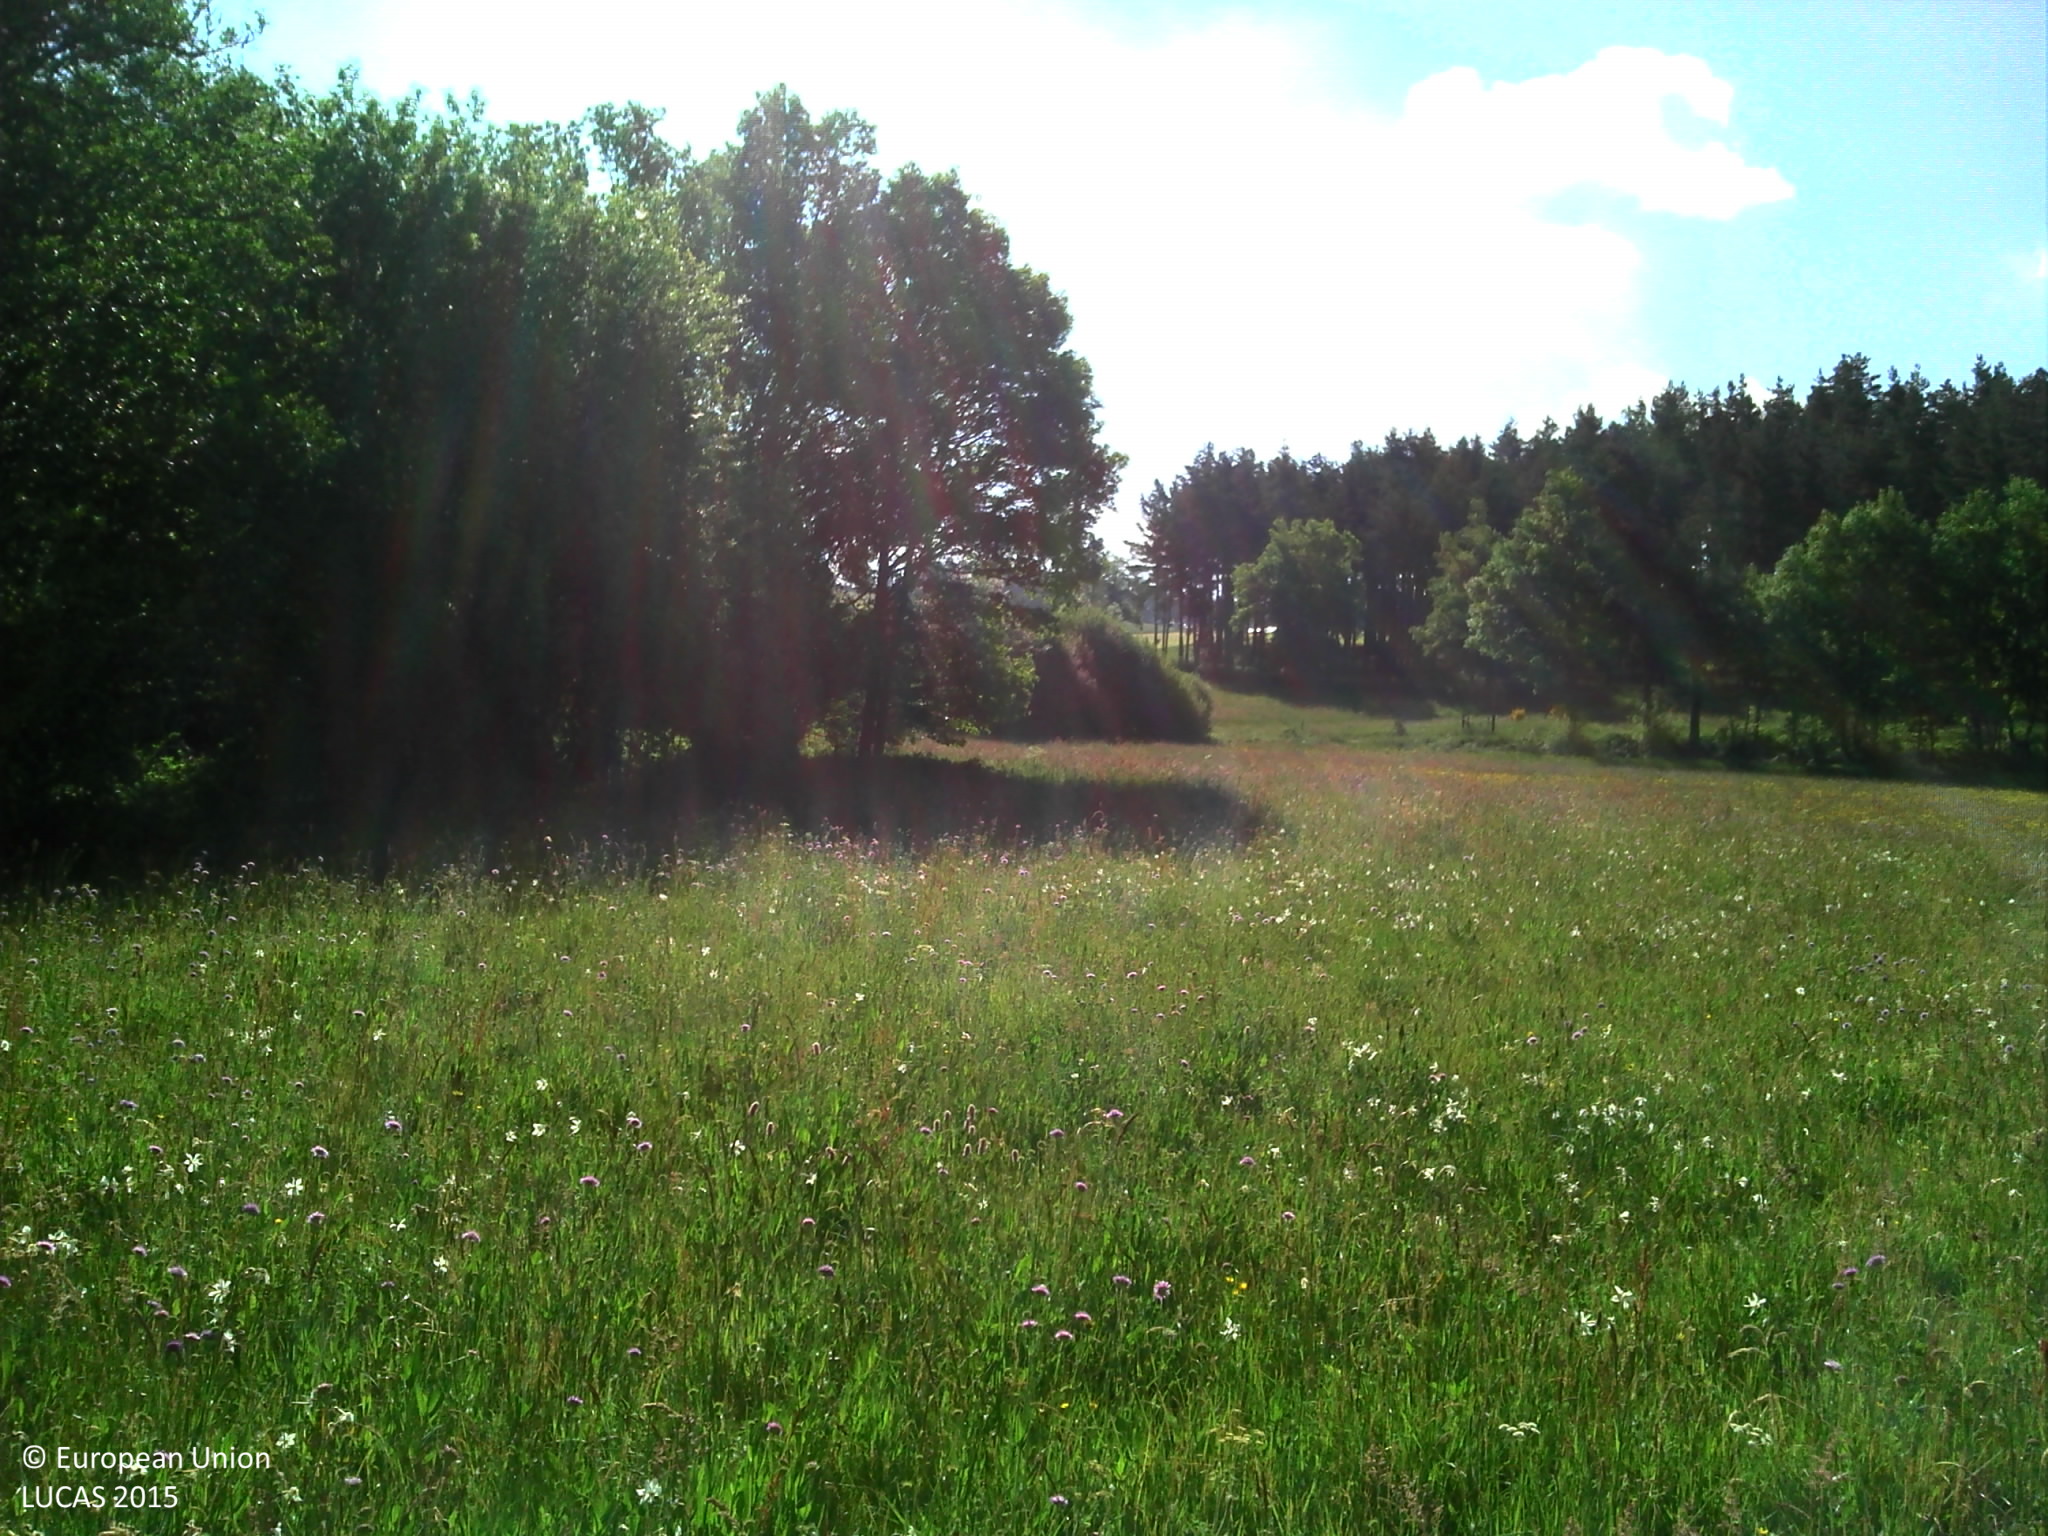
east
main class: Grassland
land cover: Grassland without tree/shrub cover
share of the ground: > 75 %
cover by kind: herbaceous plants 100 %
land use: Agriculture (excluding fallow land and kitchen gardens)
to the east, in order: Grassland without tree/shrub cover; Spontaneously vegetated surfaces; Broadleaved woodland; Spontaneously vegetated surfaces; Ditches and canals; Abandoned hedges; Spontaneously vegetated surfaces; Grassland without tree/shrub cover; Paved roads, cycling and walking lanes; Grass margins; Fences; Grassland without tree/shrub cover; Fences; Grass margins; Paved roads, cycling and walking lanes; Grass margins; Fences; Grassland without tree/shrub cover
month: June
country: FR
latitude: 44.9625
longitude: 3.2458
